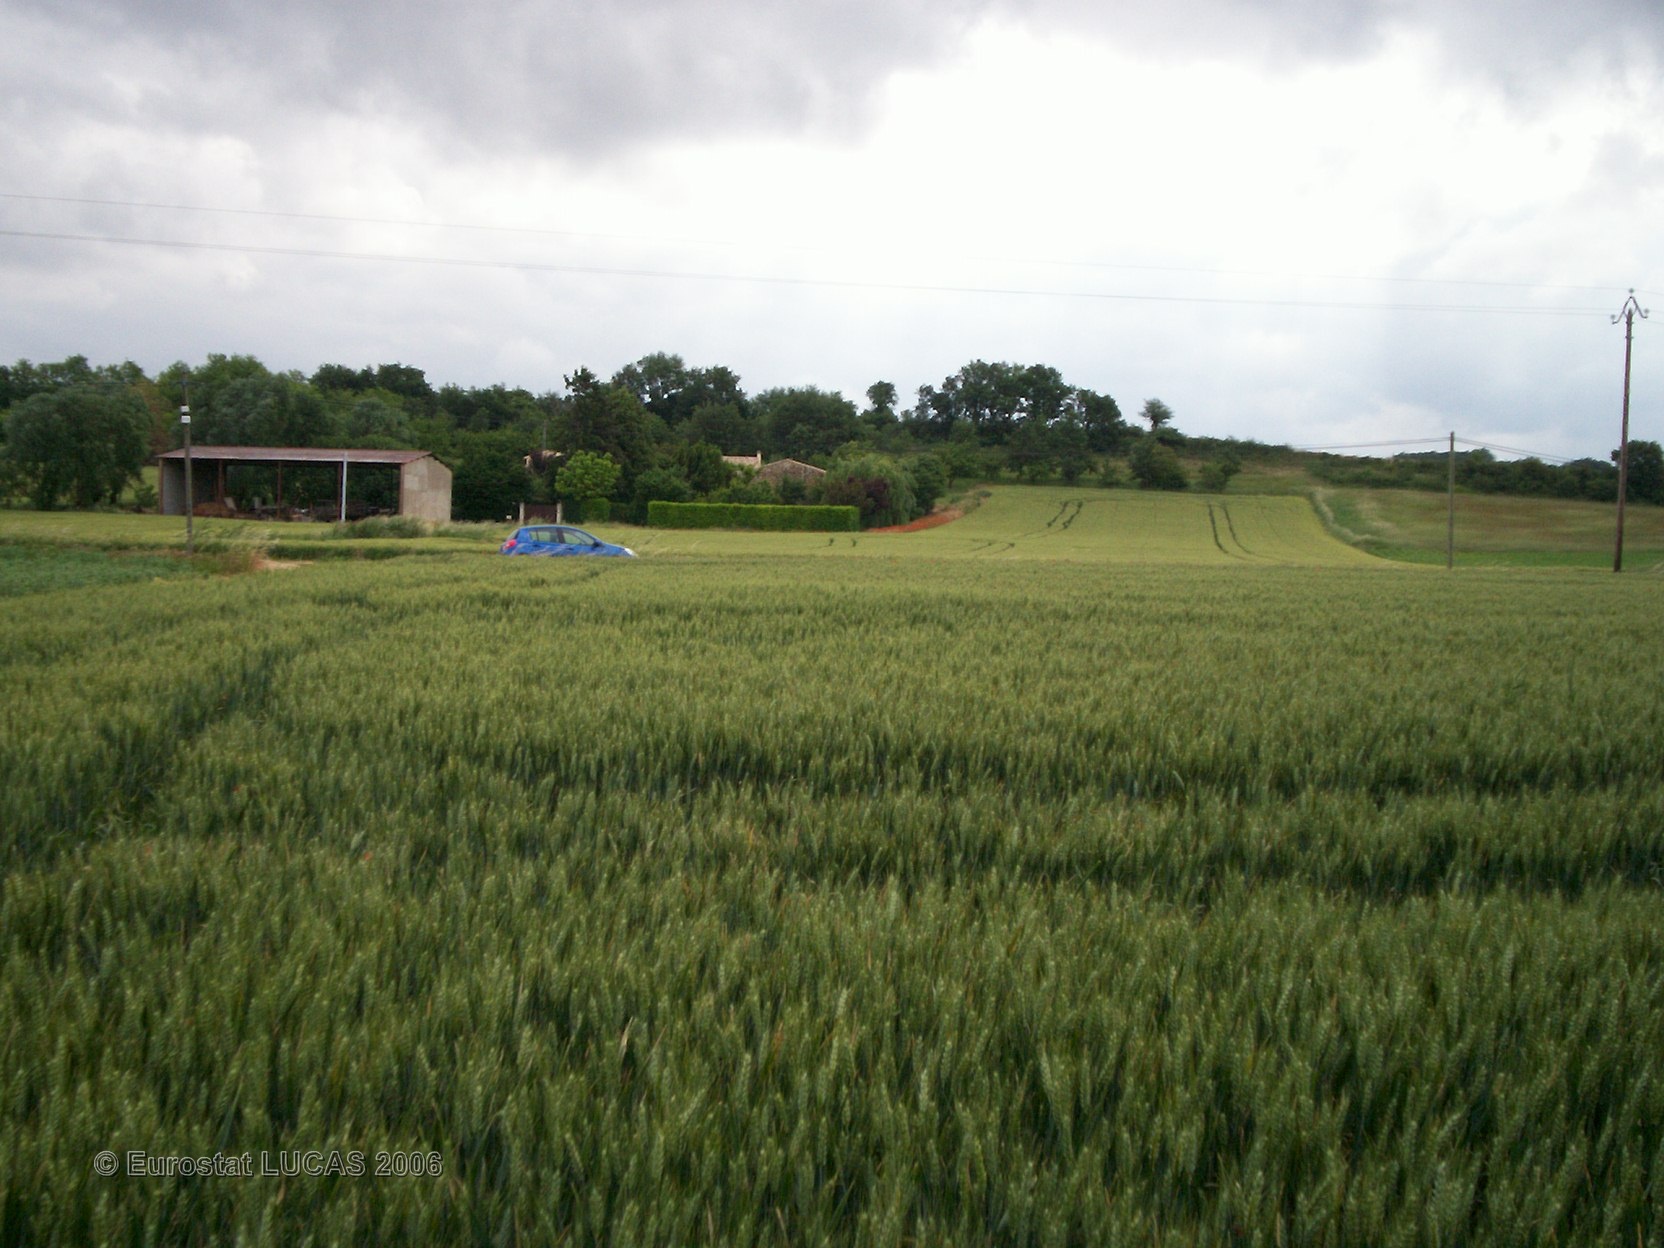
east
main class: Grassland
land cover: Grassland without tree/shrub cover
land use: Agriculture (excluding fallow land and kitchen gardens)
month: June
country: FR
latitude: 44.8206
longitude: 4.8842
